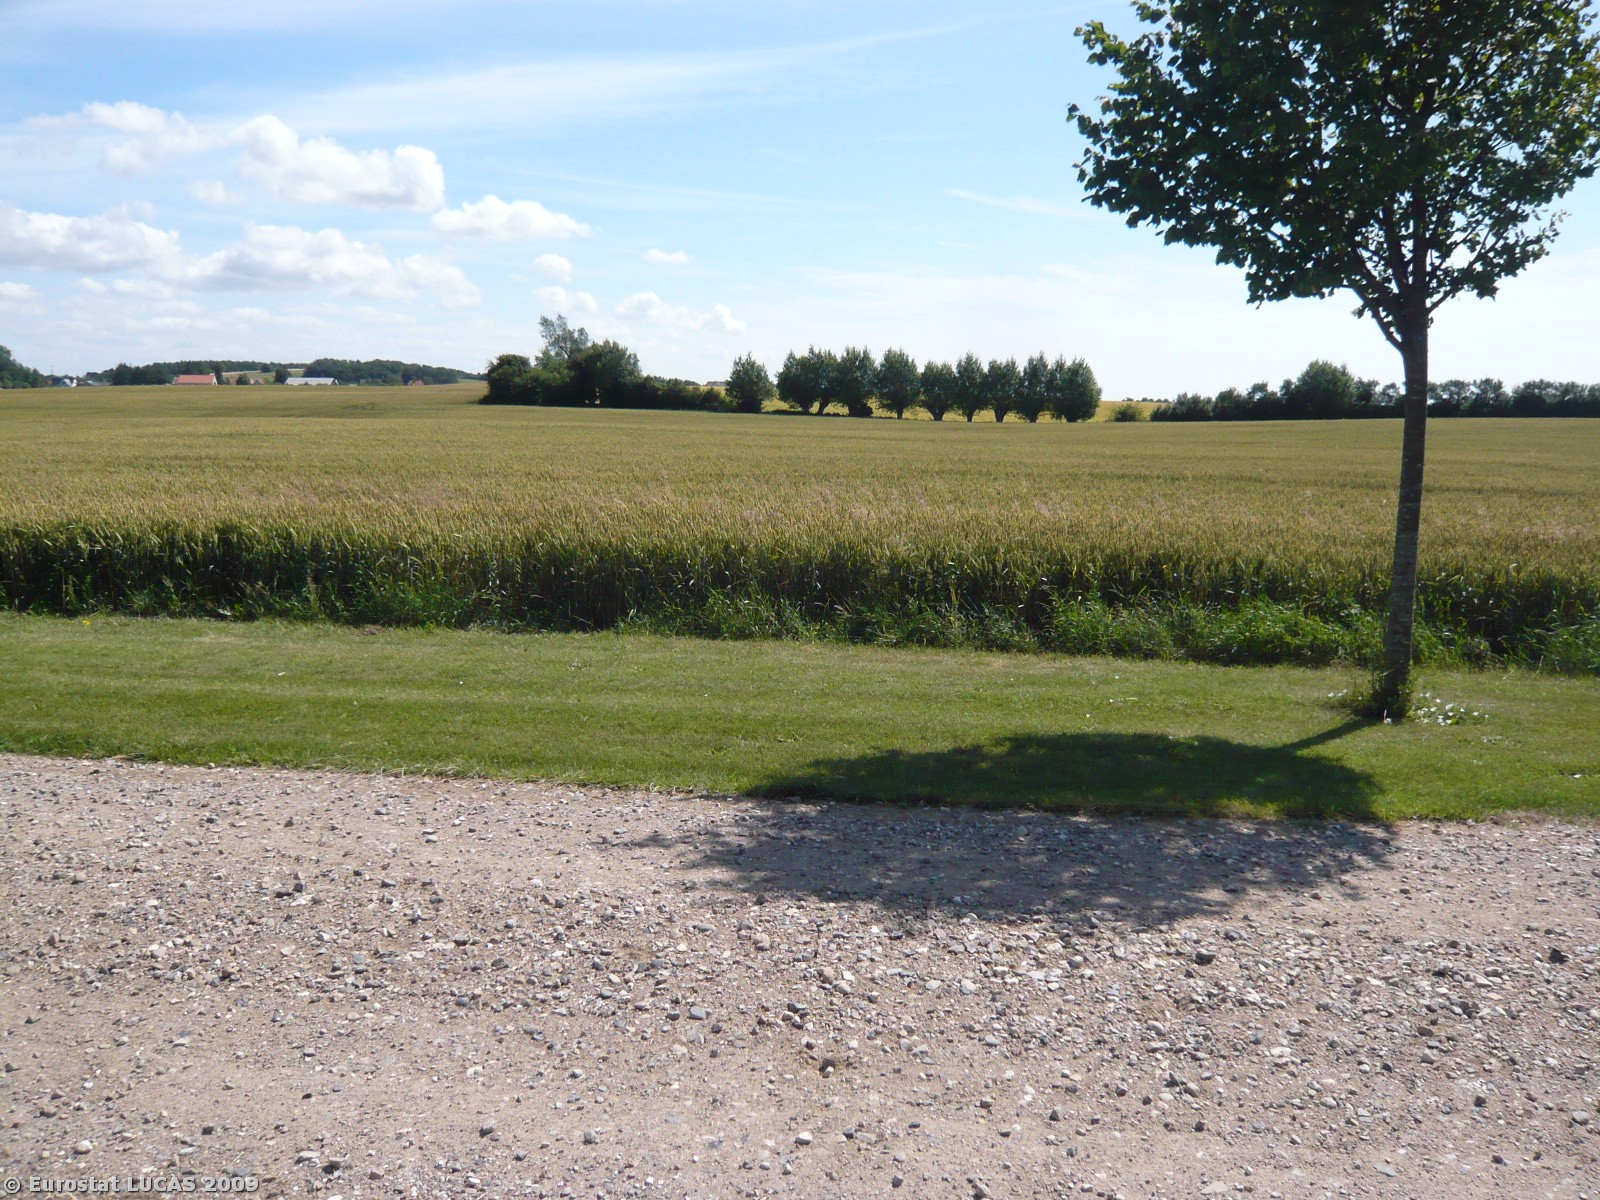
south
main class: Cropland
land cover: Barley
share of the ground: > 75 %
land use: Agriculture (excluding fallow land and kitchen gardens)
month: July
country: DK
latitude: 55.6974
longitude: 11.1285
